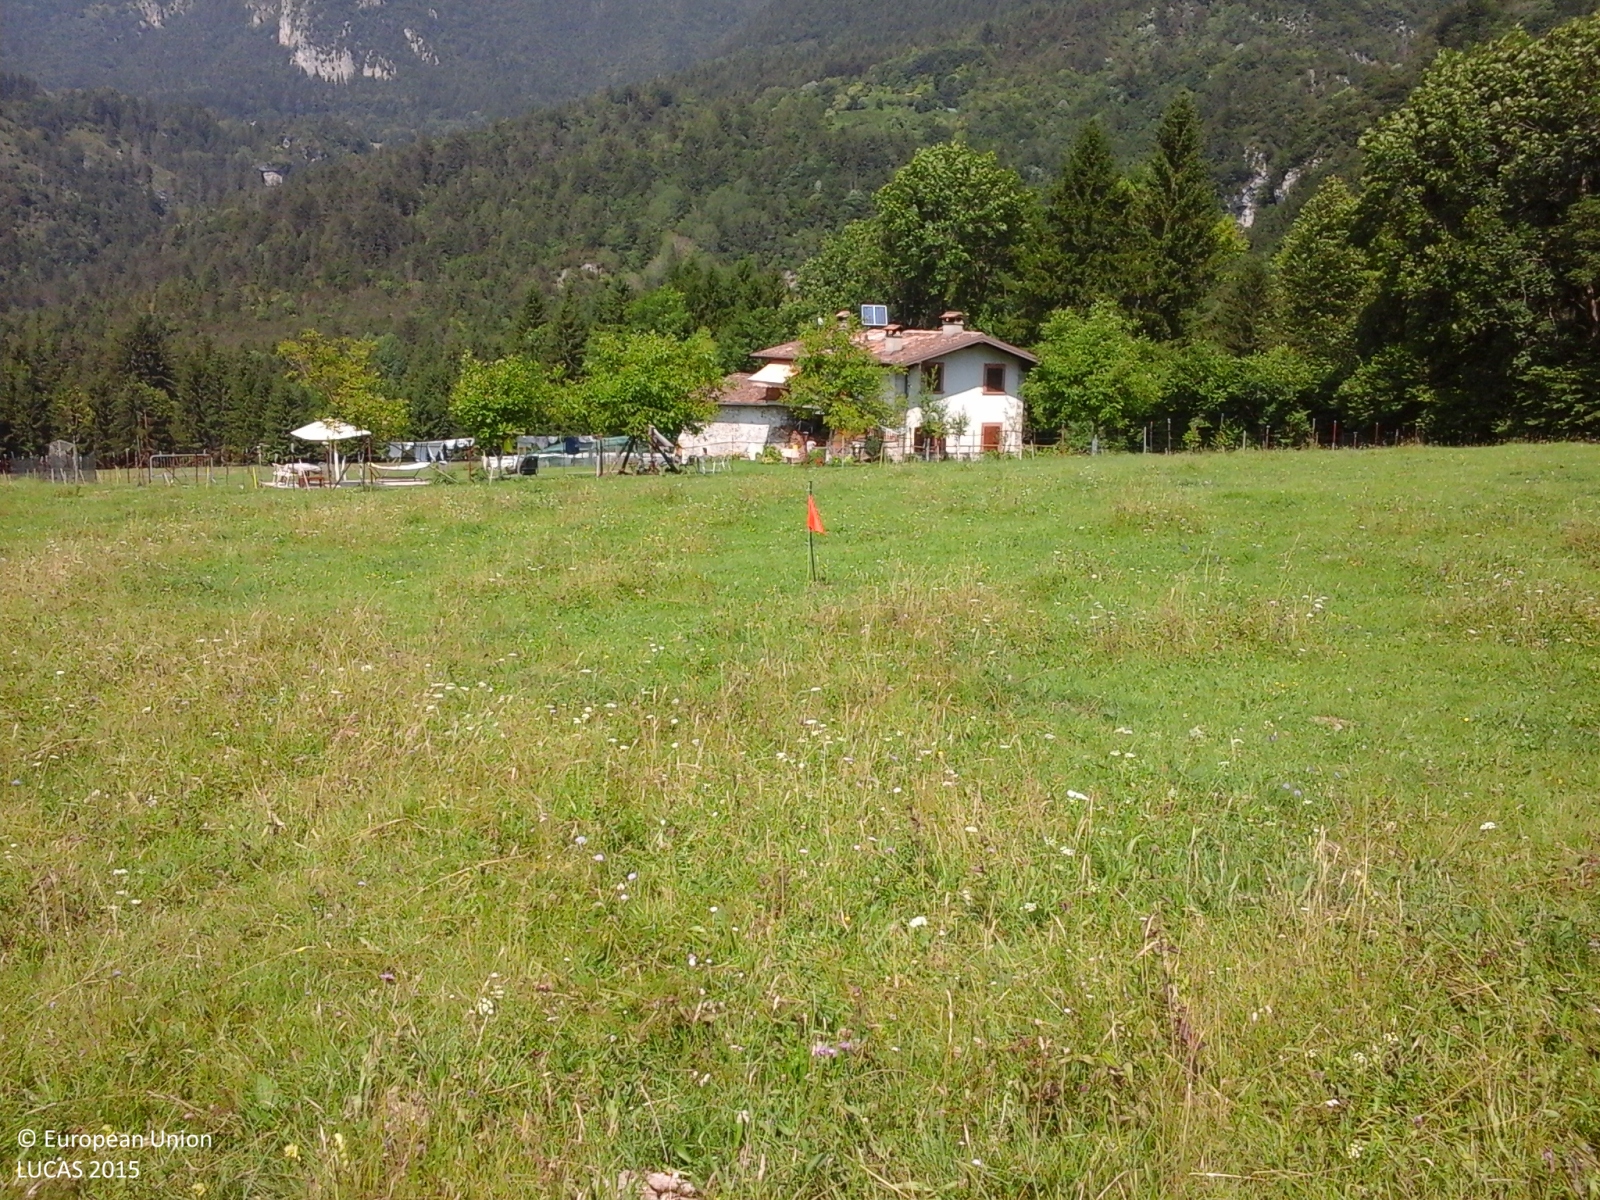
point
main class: Grassland
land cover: Grassland without tree/shrub cover
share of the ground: > 75 %
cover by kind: herbaceous plants 100 %
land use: Agriculture (excluding fallow land and kitchen gardens)
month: July
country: IT
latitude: 45.9008
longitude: 10.0643
